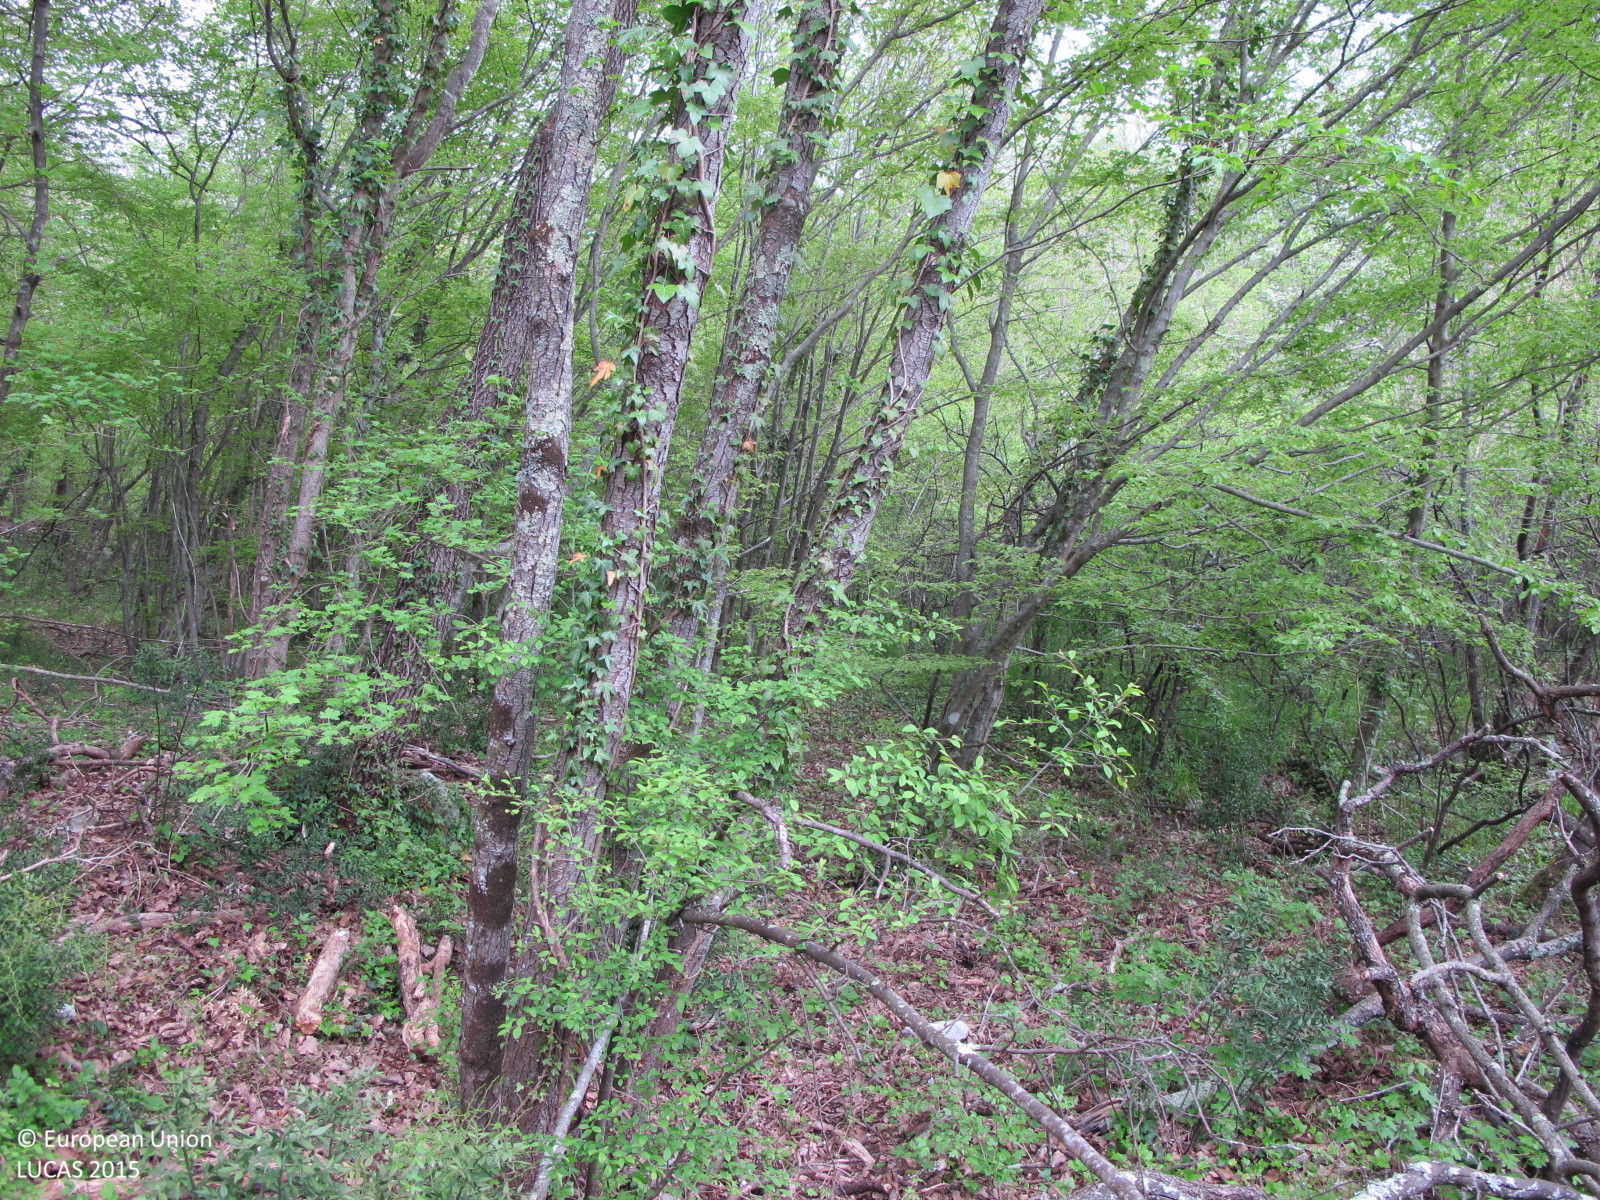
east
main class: Woodland
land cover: Broadleaved woodland
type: thermophilous deciduous forest
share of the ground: > 75 %
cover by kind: broadleaved forest trees 70 %, shrubs 15 %, herbaceous plants 5 %
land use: Semi-natural and natural areas not in use
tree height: > 5 m
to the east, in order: Broadleaved woodland; Shrubland without tree cover; Rocks and stones; Broadleaved woodland; Dry stone walls; Broadleaved woodland; Rocks and stones; Broadleaved woodland; Dry stone walls; Rocks and stones; Grassland without tree/shrub cover
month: April
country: HR
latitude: 45.2229
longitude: 14.6177
